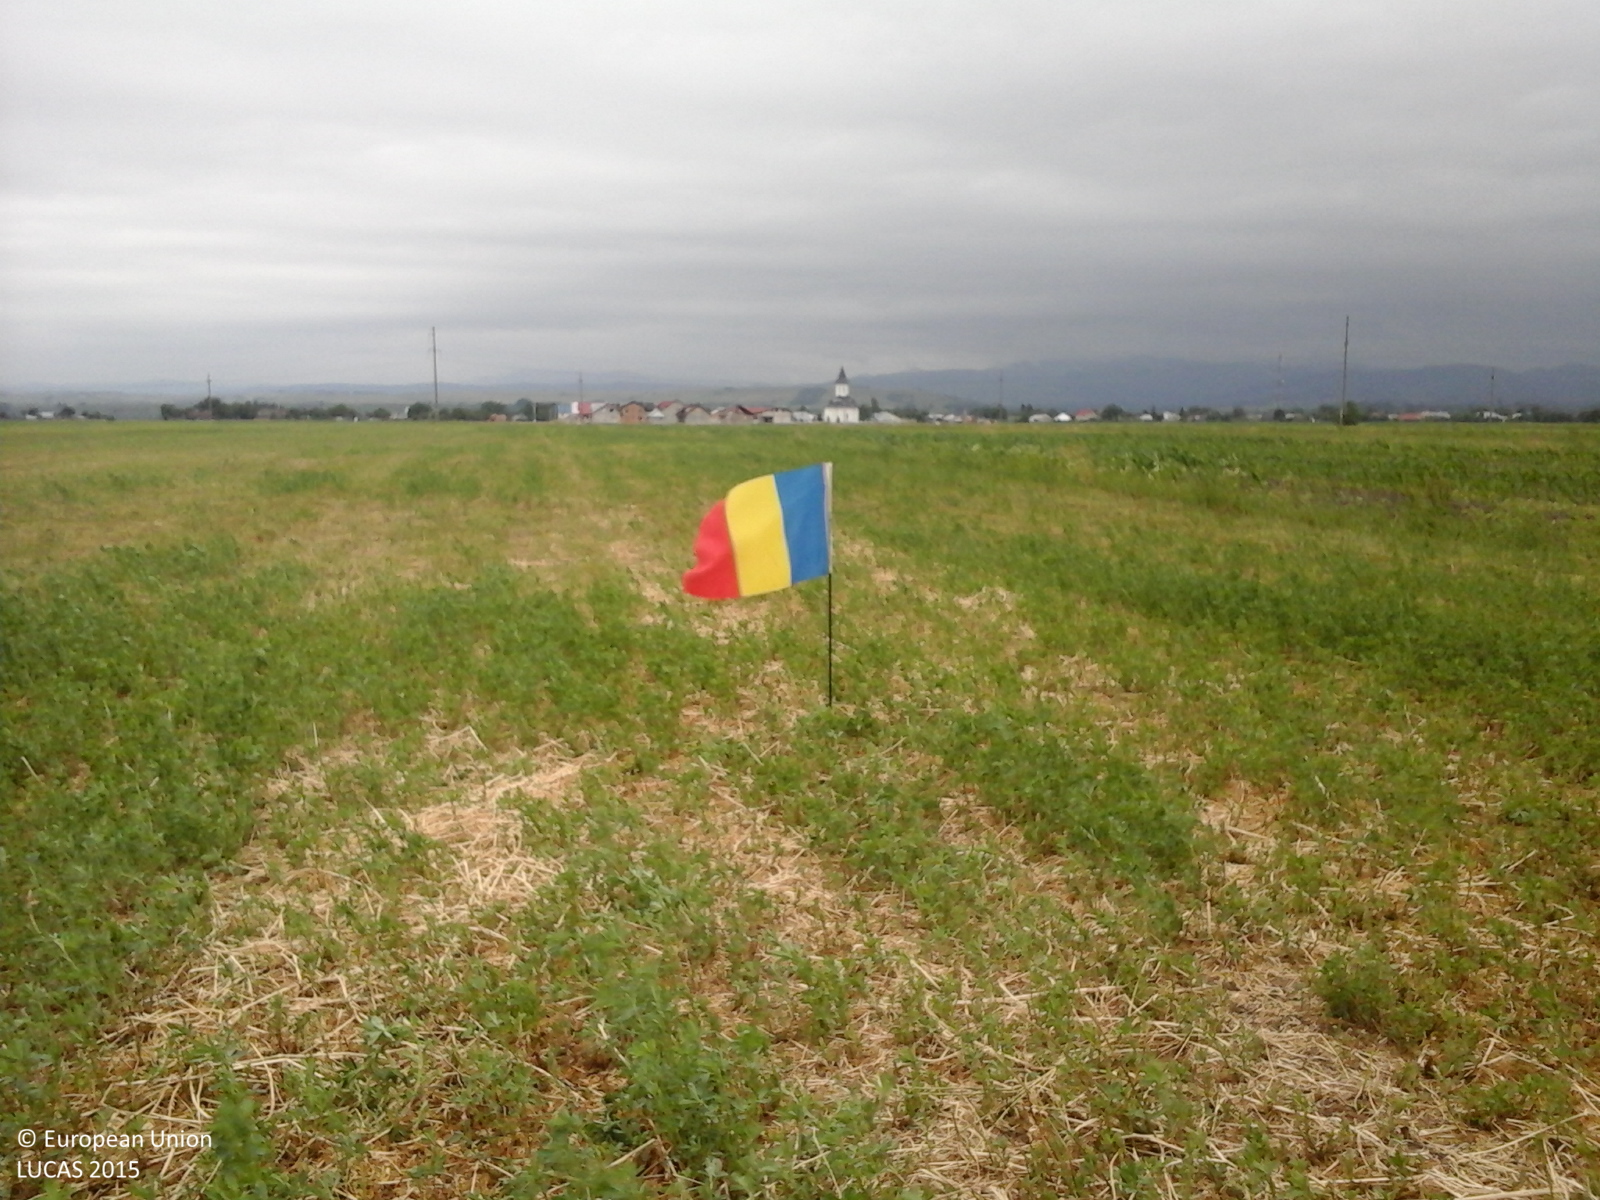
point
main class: Cropland
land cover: Lucerne
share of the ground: > 75 %
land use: Agriculture (excluding fallow land and kitchen gardens)
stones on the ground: < 10 %
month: June
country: RO
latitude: 46.8086
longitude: 26.5851
